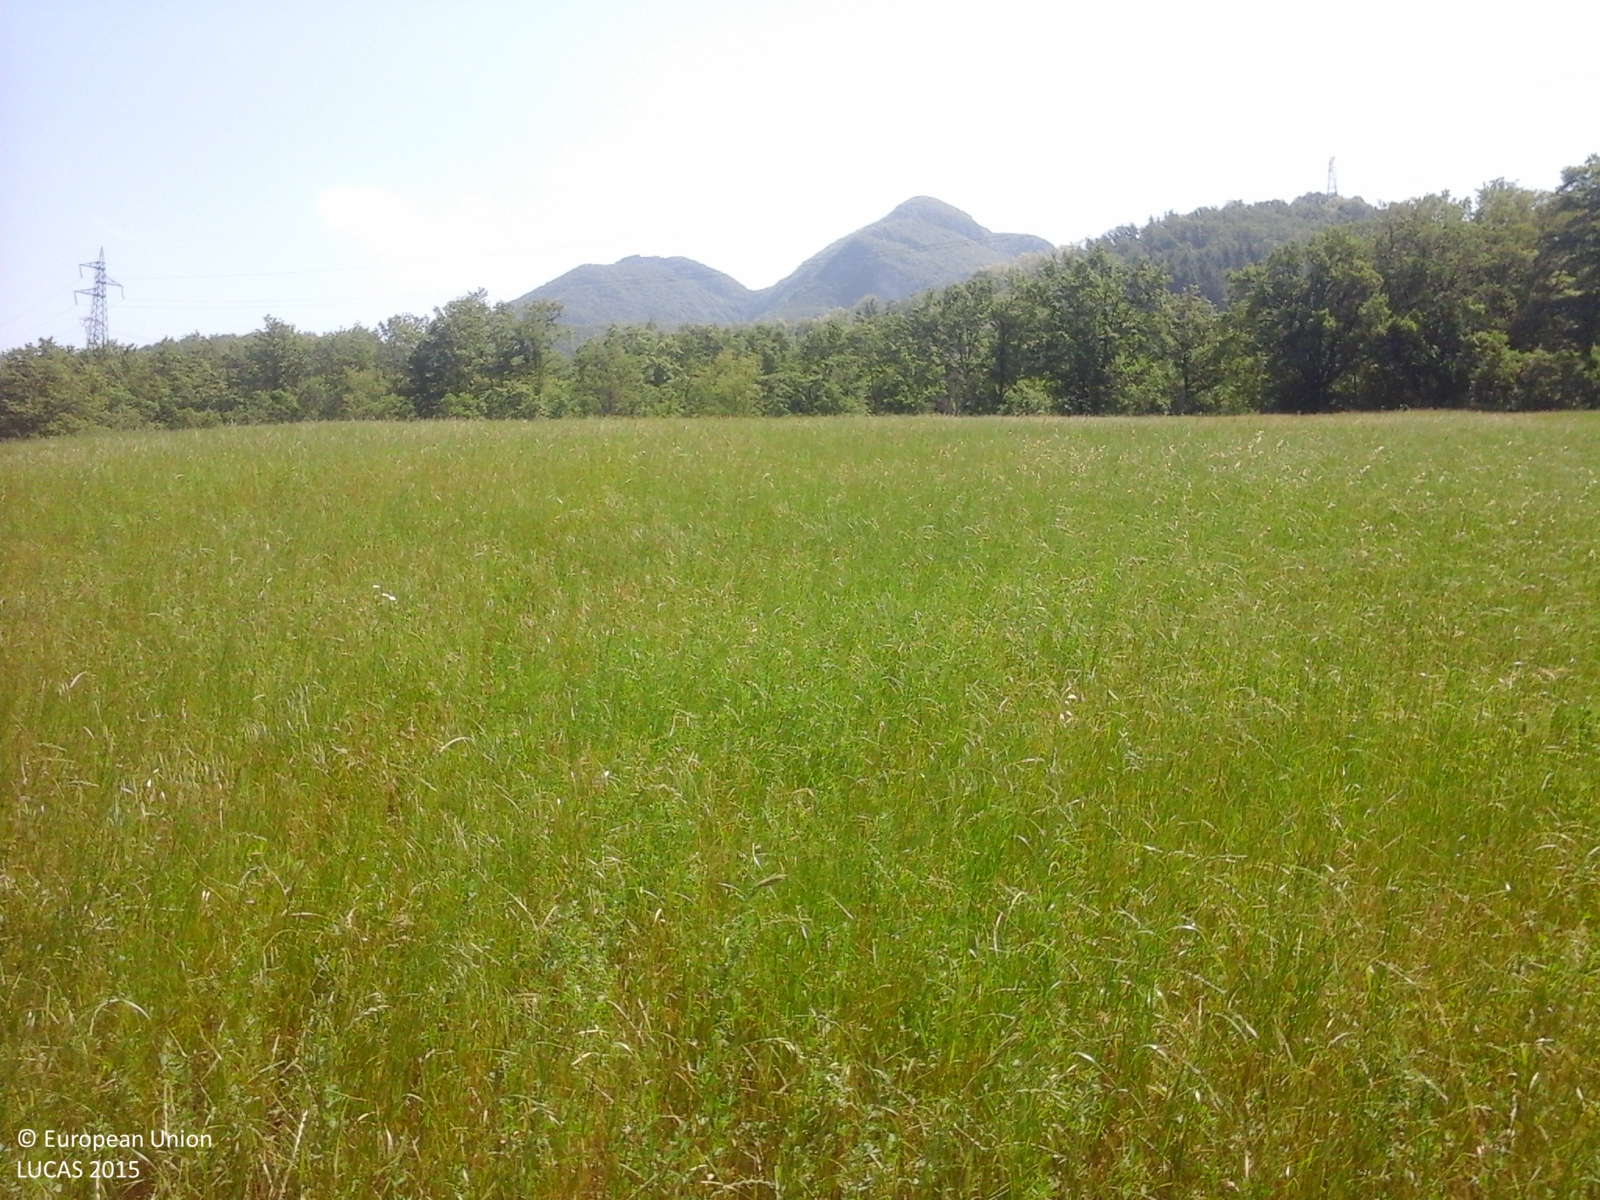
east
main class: Grassland
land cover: Grassland without tree/shrub cover
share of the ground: > 75 %
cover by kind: herbaceous plants 100 %
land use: Agriculture (excluding fallow land and kitchen gardens)
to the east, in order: Grassland without tree/shrub cover; Broadleaved woodland; Grassland without tree/shrub cover; Broadleaved woodland; Electric lines; Broadleaved woodland; Paved roads, cycling and walking lanes; Ditches and canals; Broadleaved woodland
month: May
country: IT
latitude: 44.2189
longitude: 11.0614
